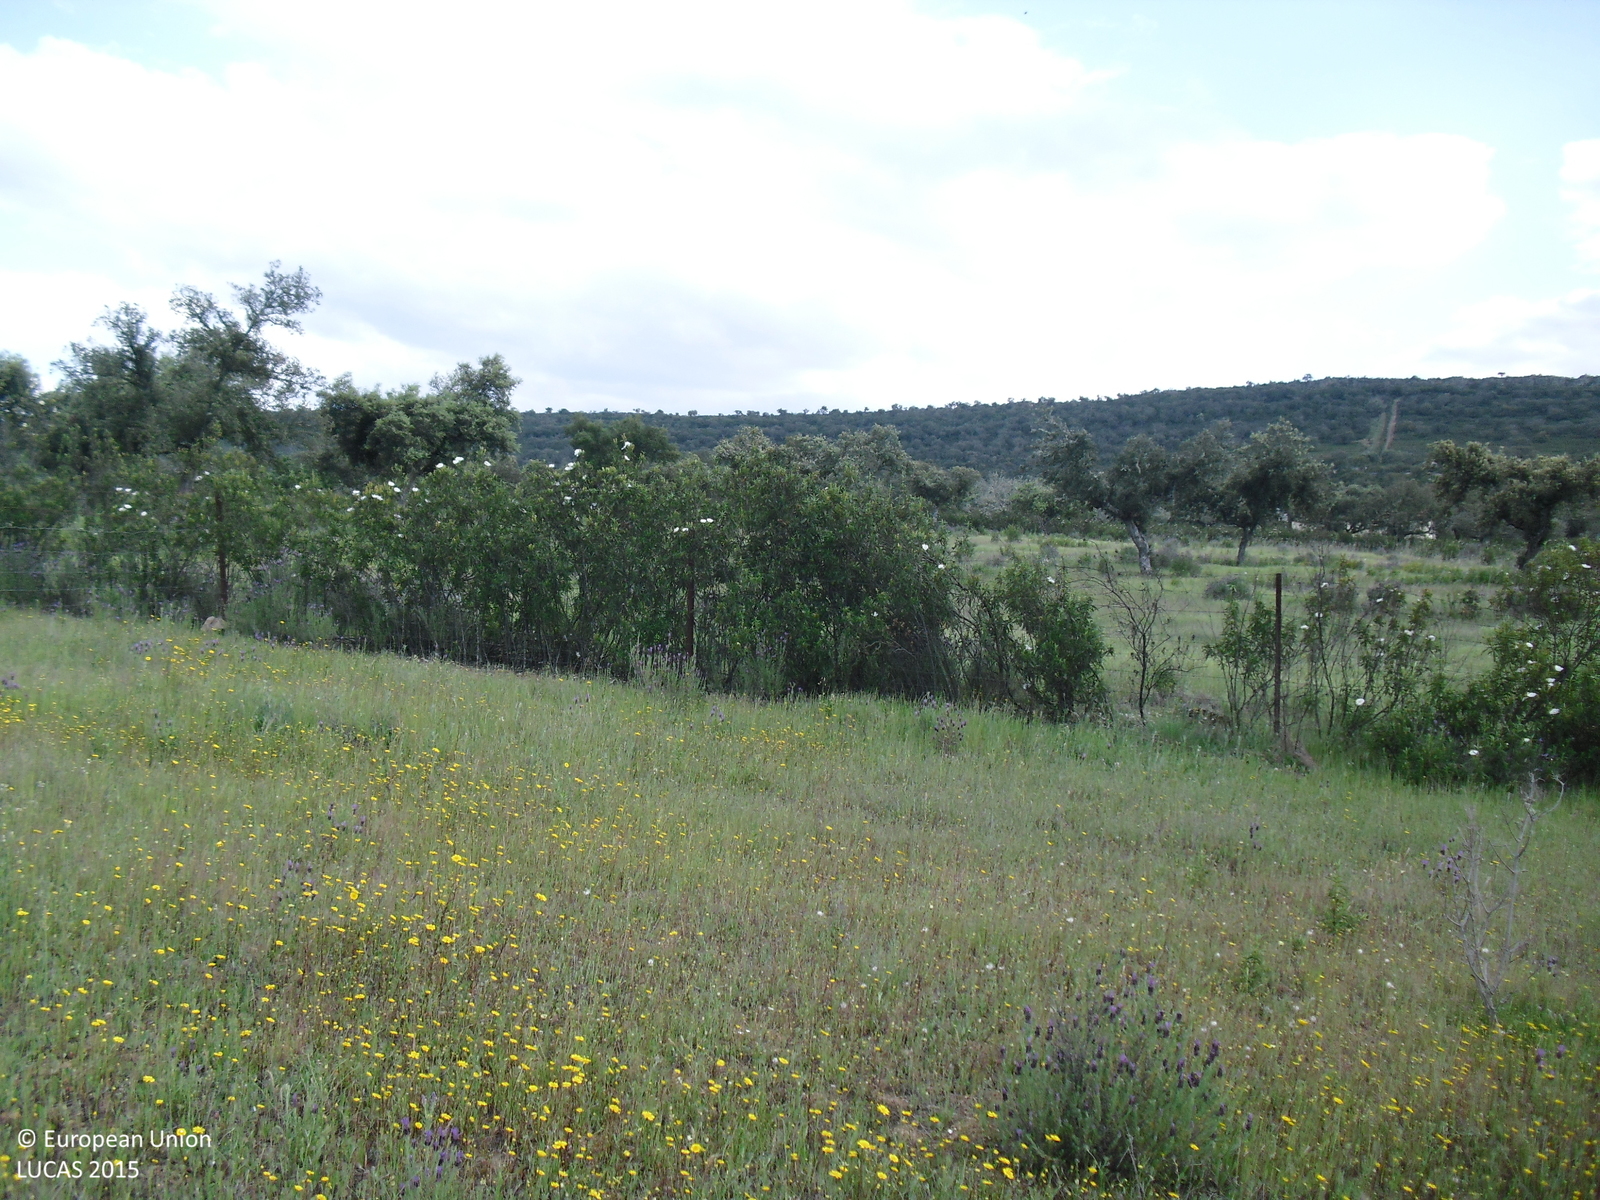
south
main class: Cropland
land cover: Pear fruit
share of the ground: < 10 %
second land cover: Spontaneously vegetated surfaces
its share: > 75 %
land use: Kitchen garden
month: April
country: ES
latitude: 39.3919
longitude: -6.6172
